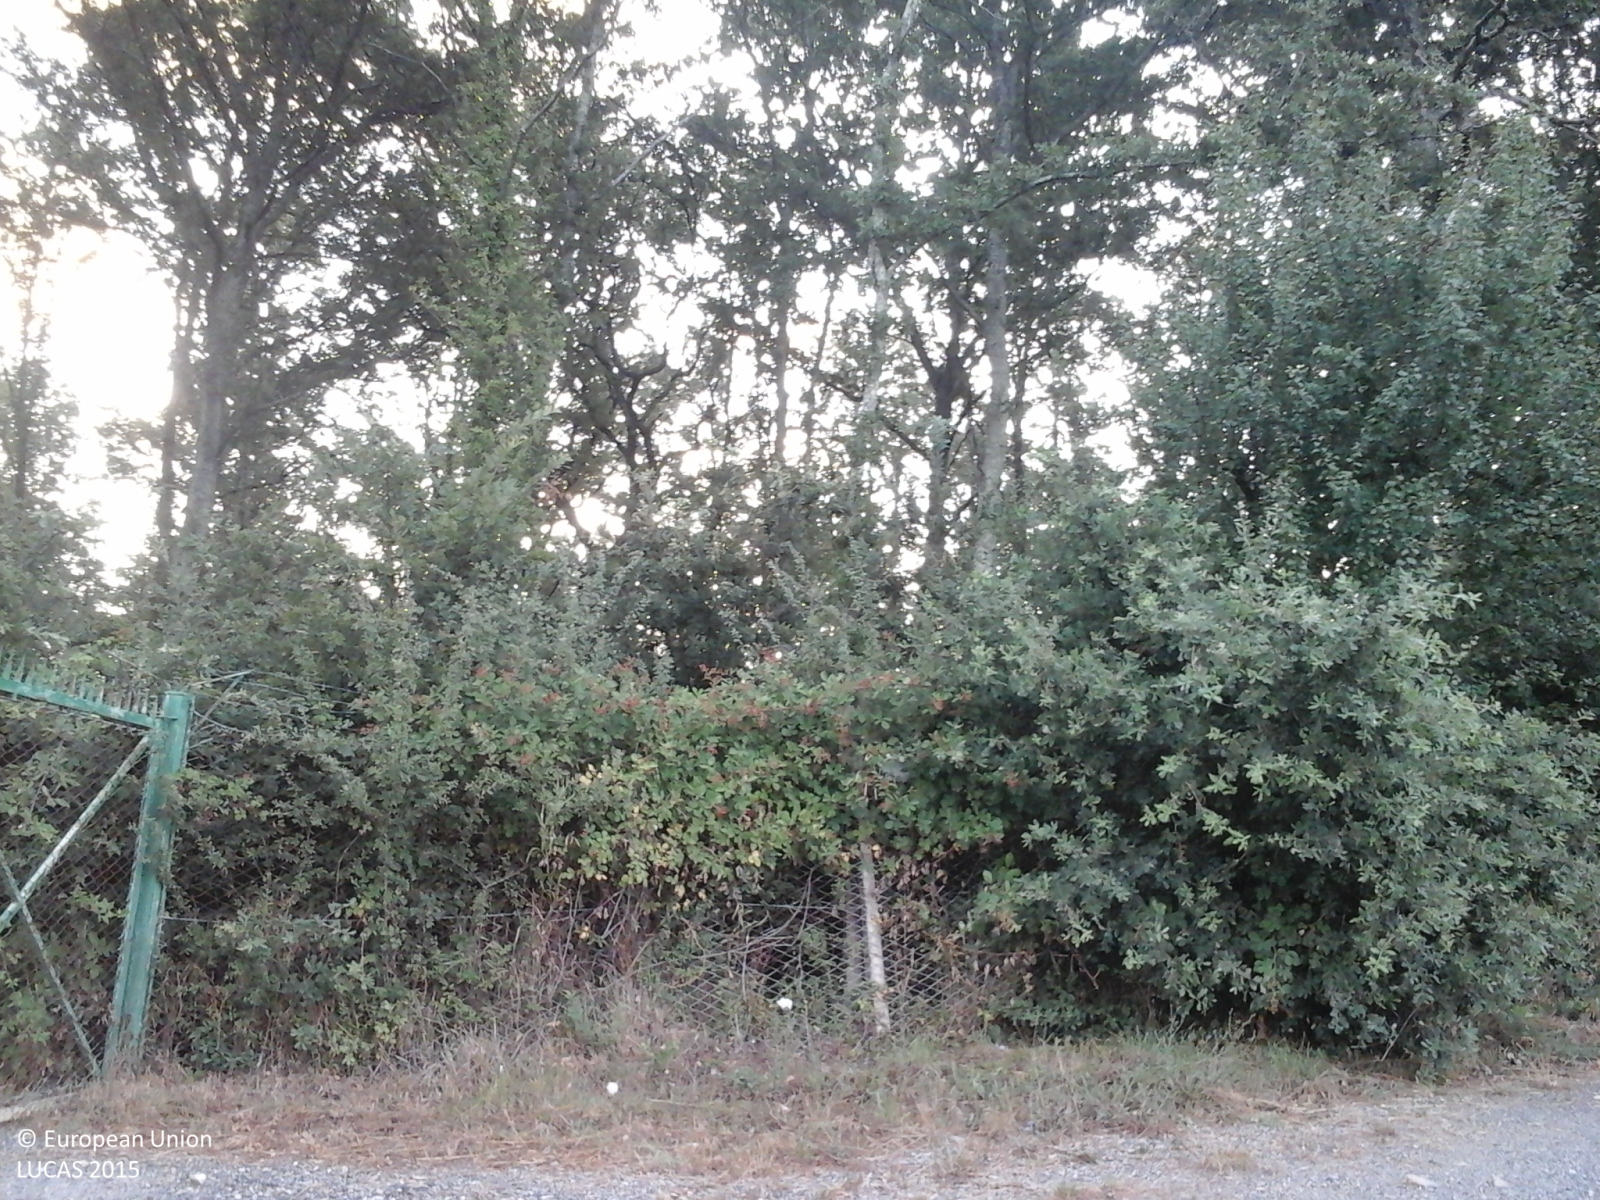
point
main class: Woodland
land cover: Broadleaved woodland
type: thermophilous deciduous forest
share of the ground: > 75 %
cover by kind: broadleaved forest trees 100 %
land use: Forestry
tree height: > 5 m
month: July
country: IT
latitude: 43.4438
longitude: 10.9734
